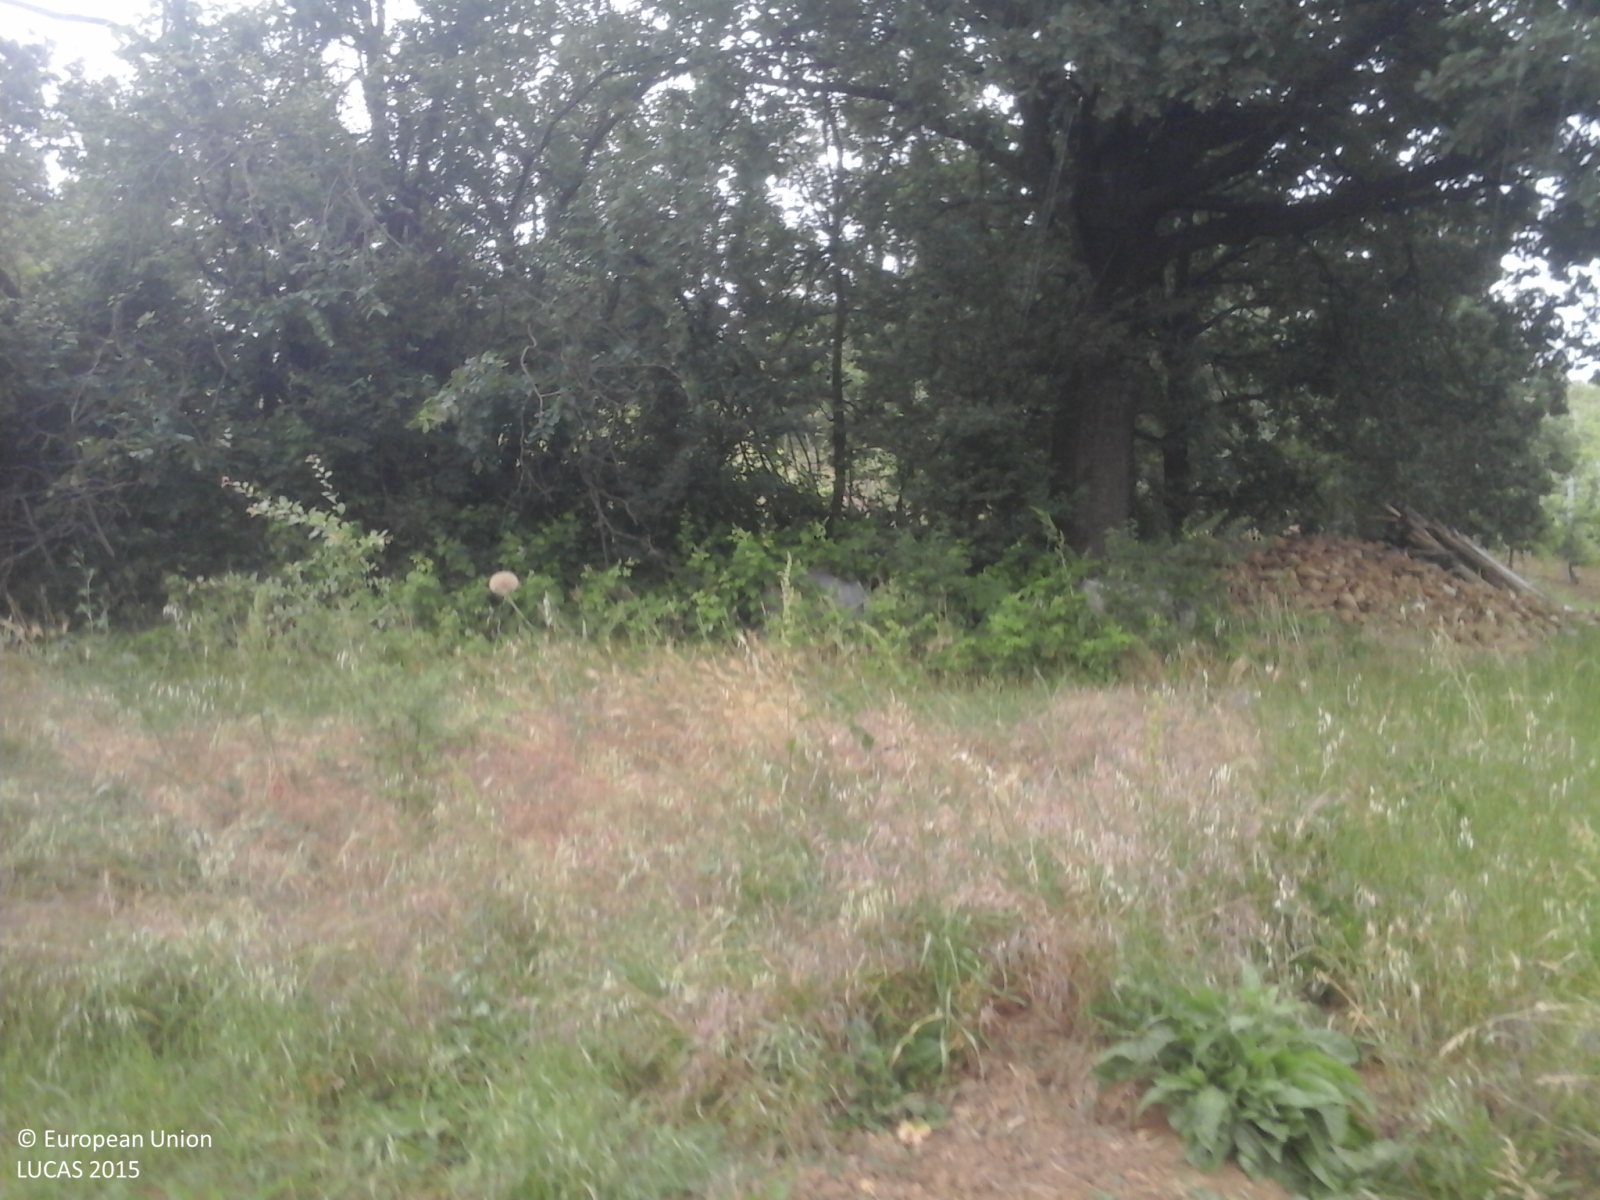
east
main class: Cropland
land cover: Lucerne
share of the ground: < 10 %
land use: Agriculture (excluding fallow land and kitchen gardens)
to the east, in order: Lucerne; Grassland without tree/shrub cover; Broadleaved woodland; Vineyards; Lines of trees; Paved roads, cycling and walking lanes; Broadleaved woodland; Grassland without tree/shrub cover; Electric lines; Grassland with sparse tree/shrub cover; Paved roads, cycling and walking lanes; Electric lines; Grassland without tree/shrub cover; Vineyards
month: May
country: IT
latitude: 44.5084
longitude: 10.9664
